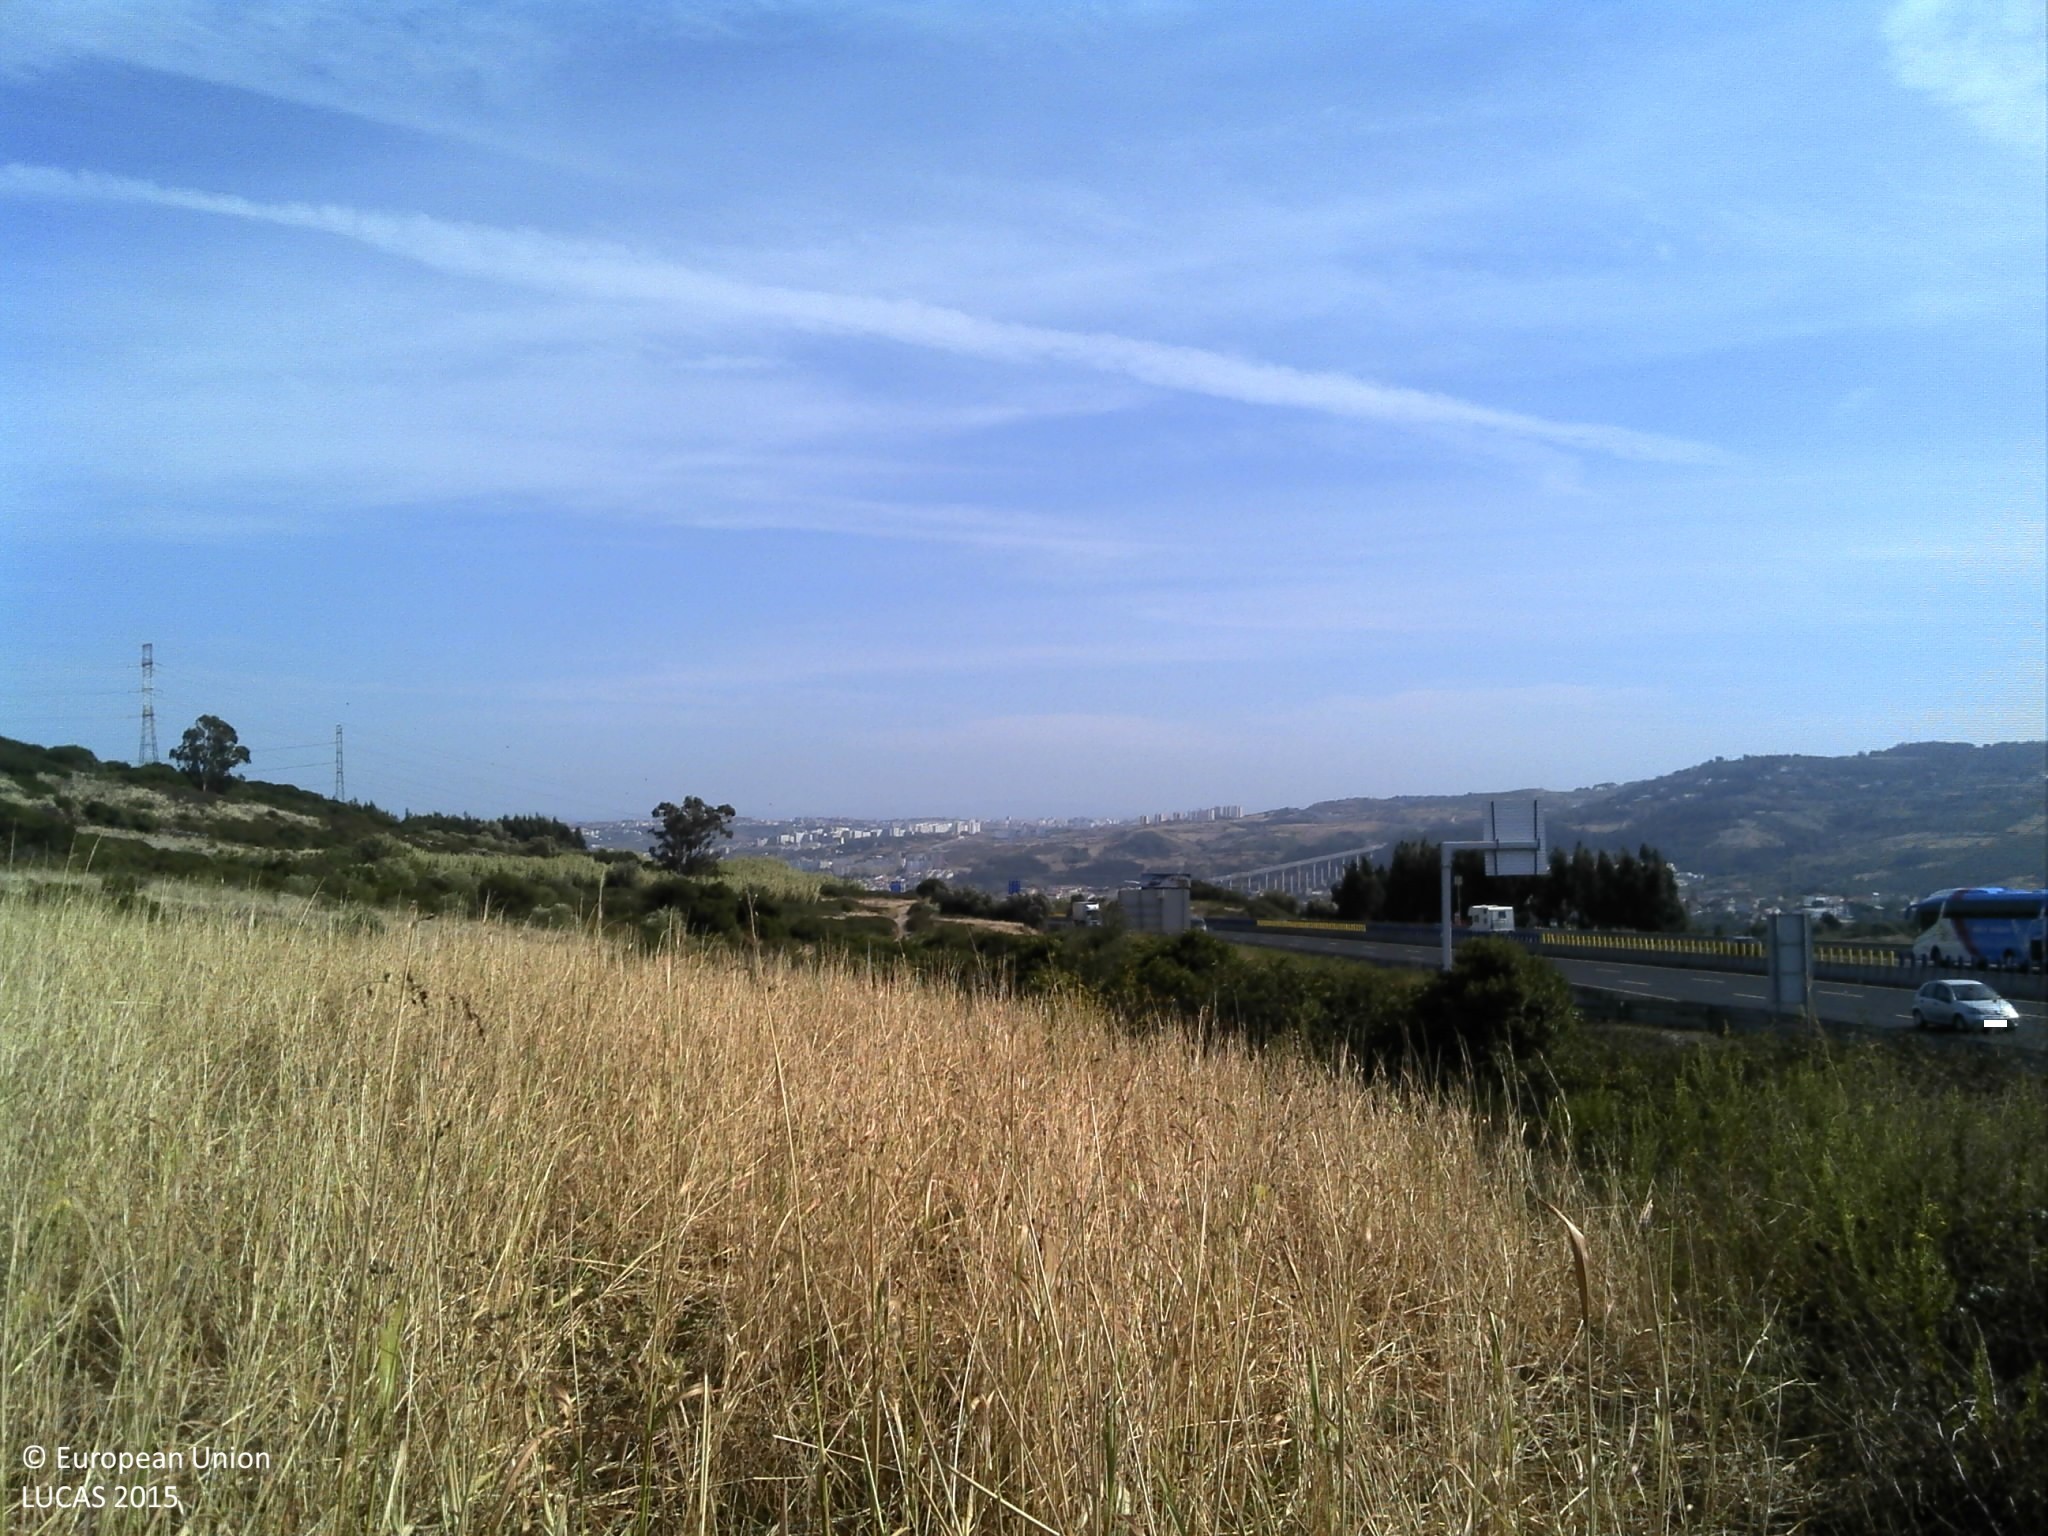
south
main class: Cropland
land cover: Other cereals
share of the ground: 50 - 75 %
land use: Agriculture (excluding fallow land and kitchen gardens)
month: September
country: PT
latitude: 38.8696
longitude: -9.2009
